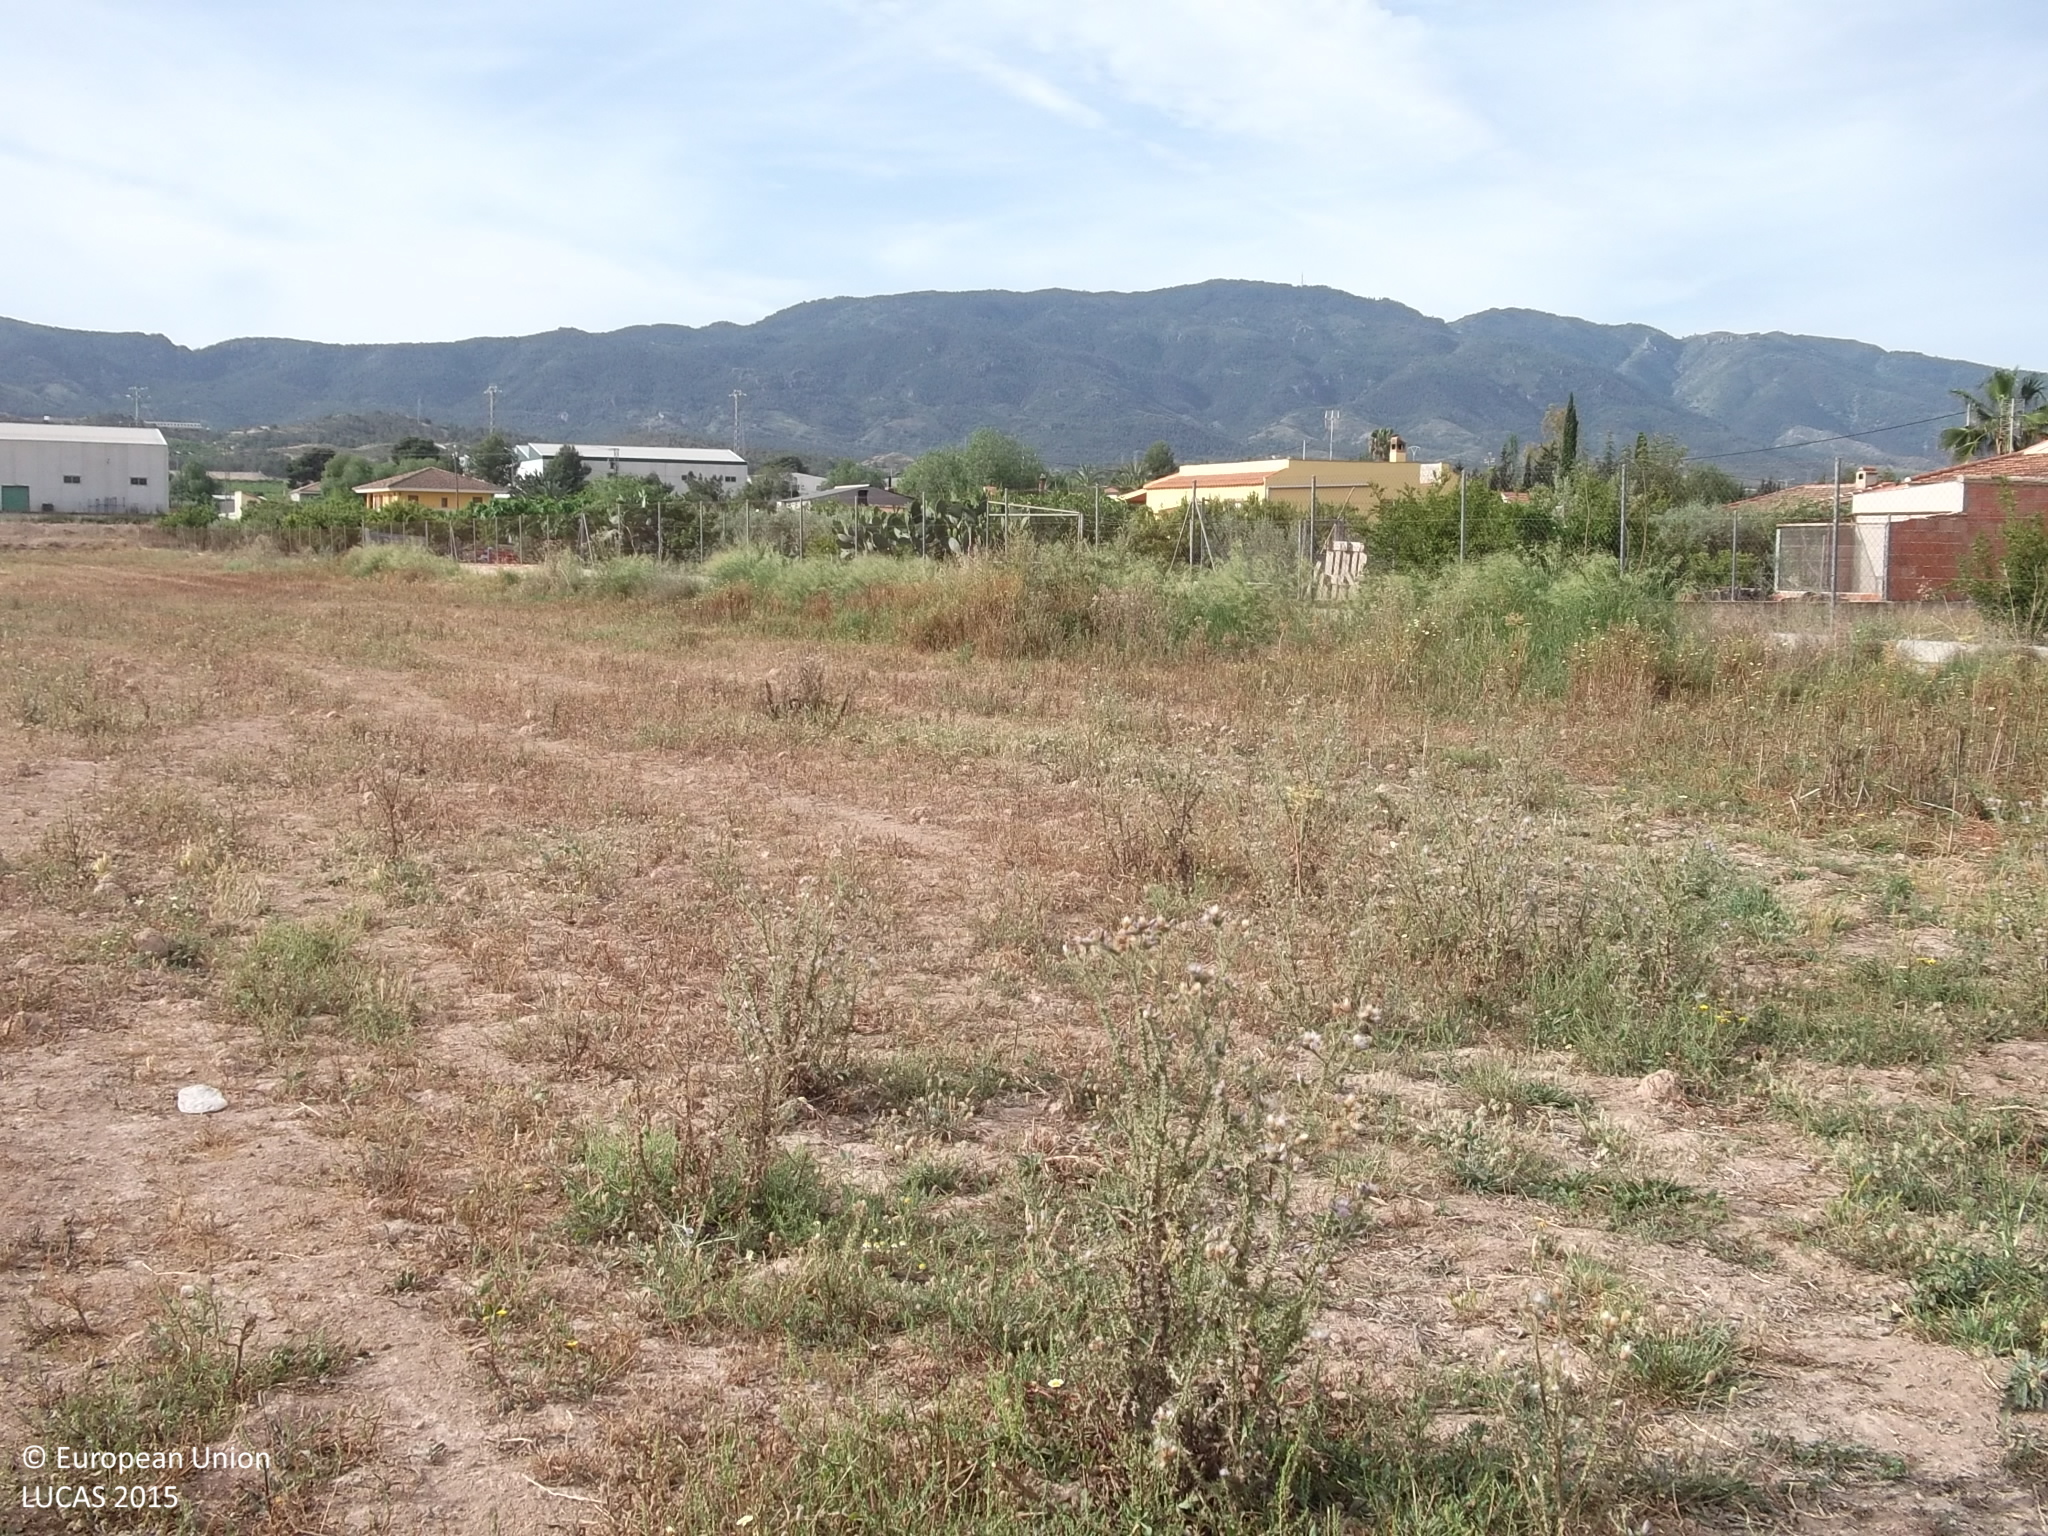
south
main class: Grassland
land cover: Spontaneously vegetated surfaces
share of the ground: 50 - 75 %
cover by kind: herbaceous plants 60 %, unconsolidated bare surface 40 %
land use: Abandoned areas
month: May
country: ES
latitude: 37.9183
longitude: -1.2565
